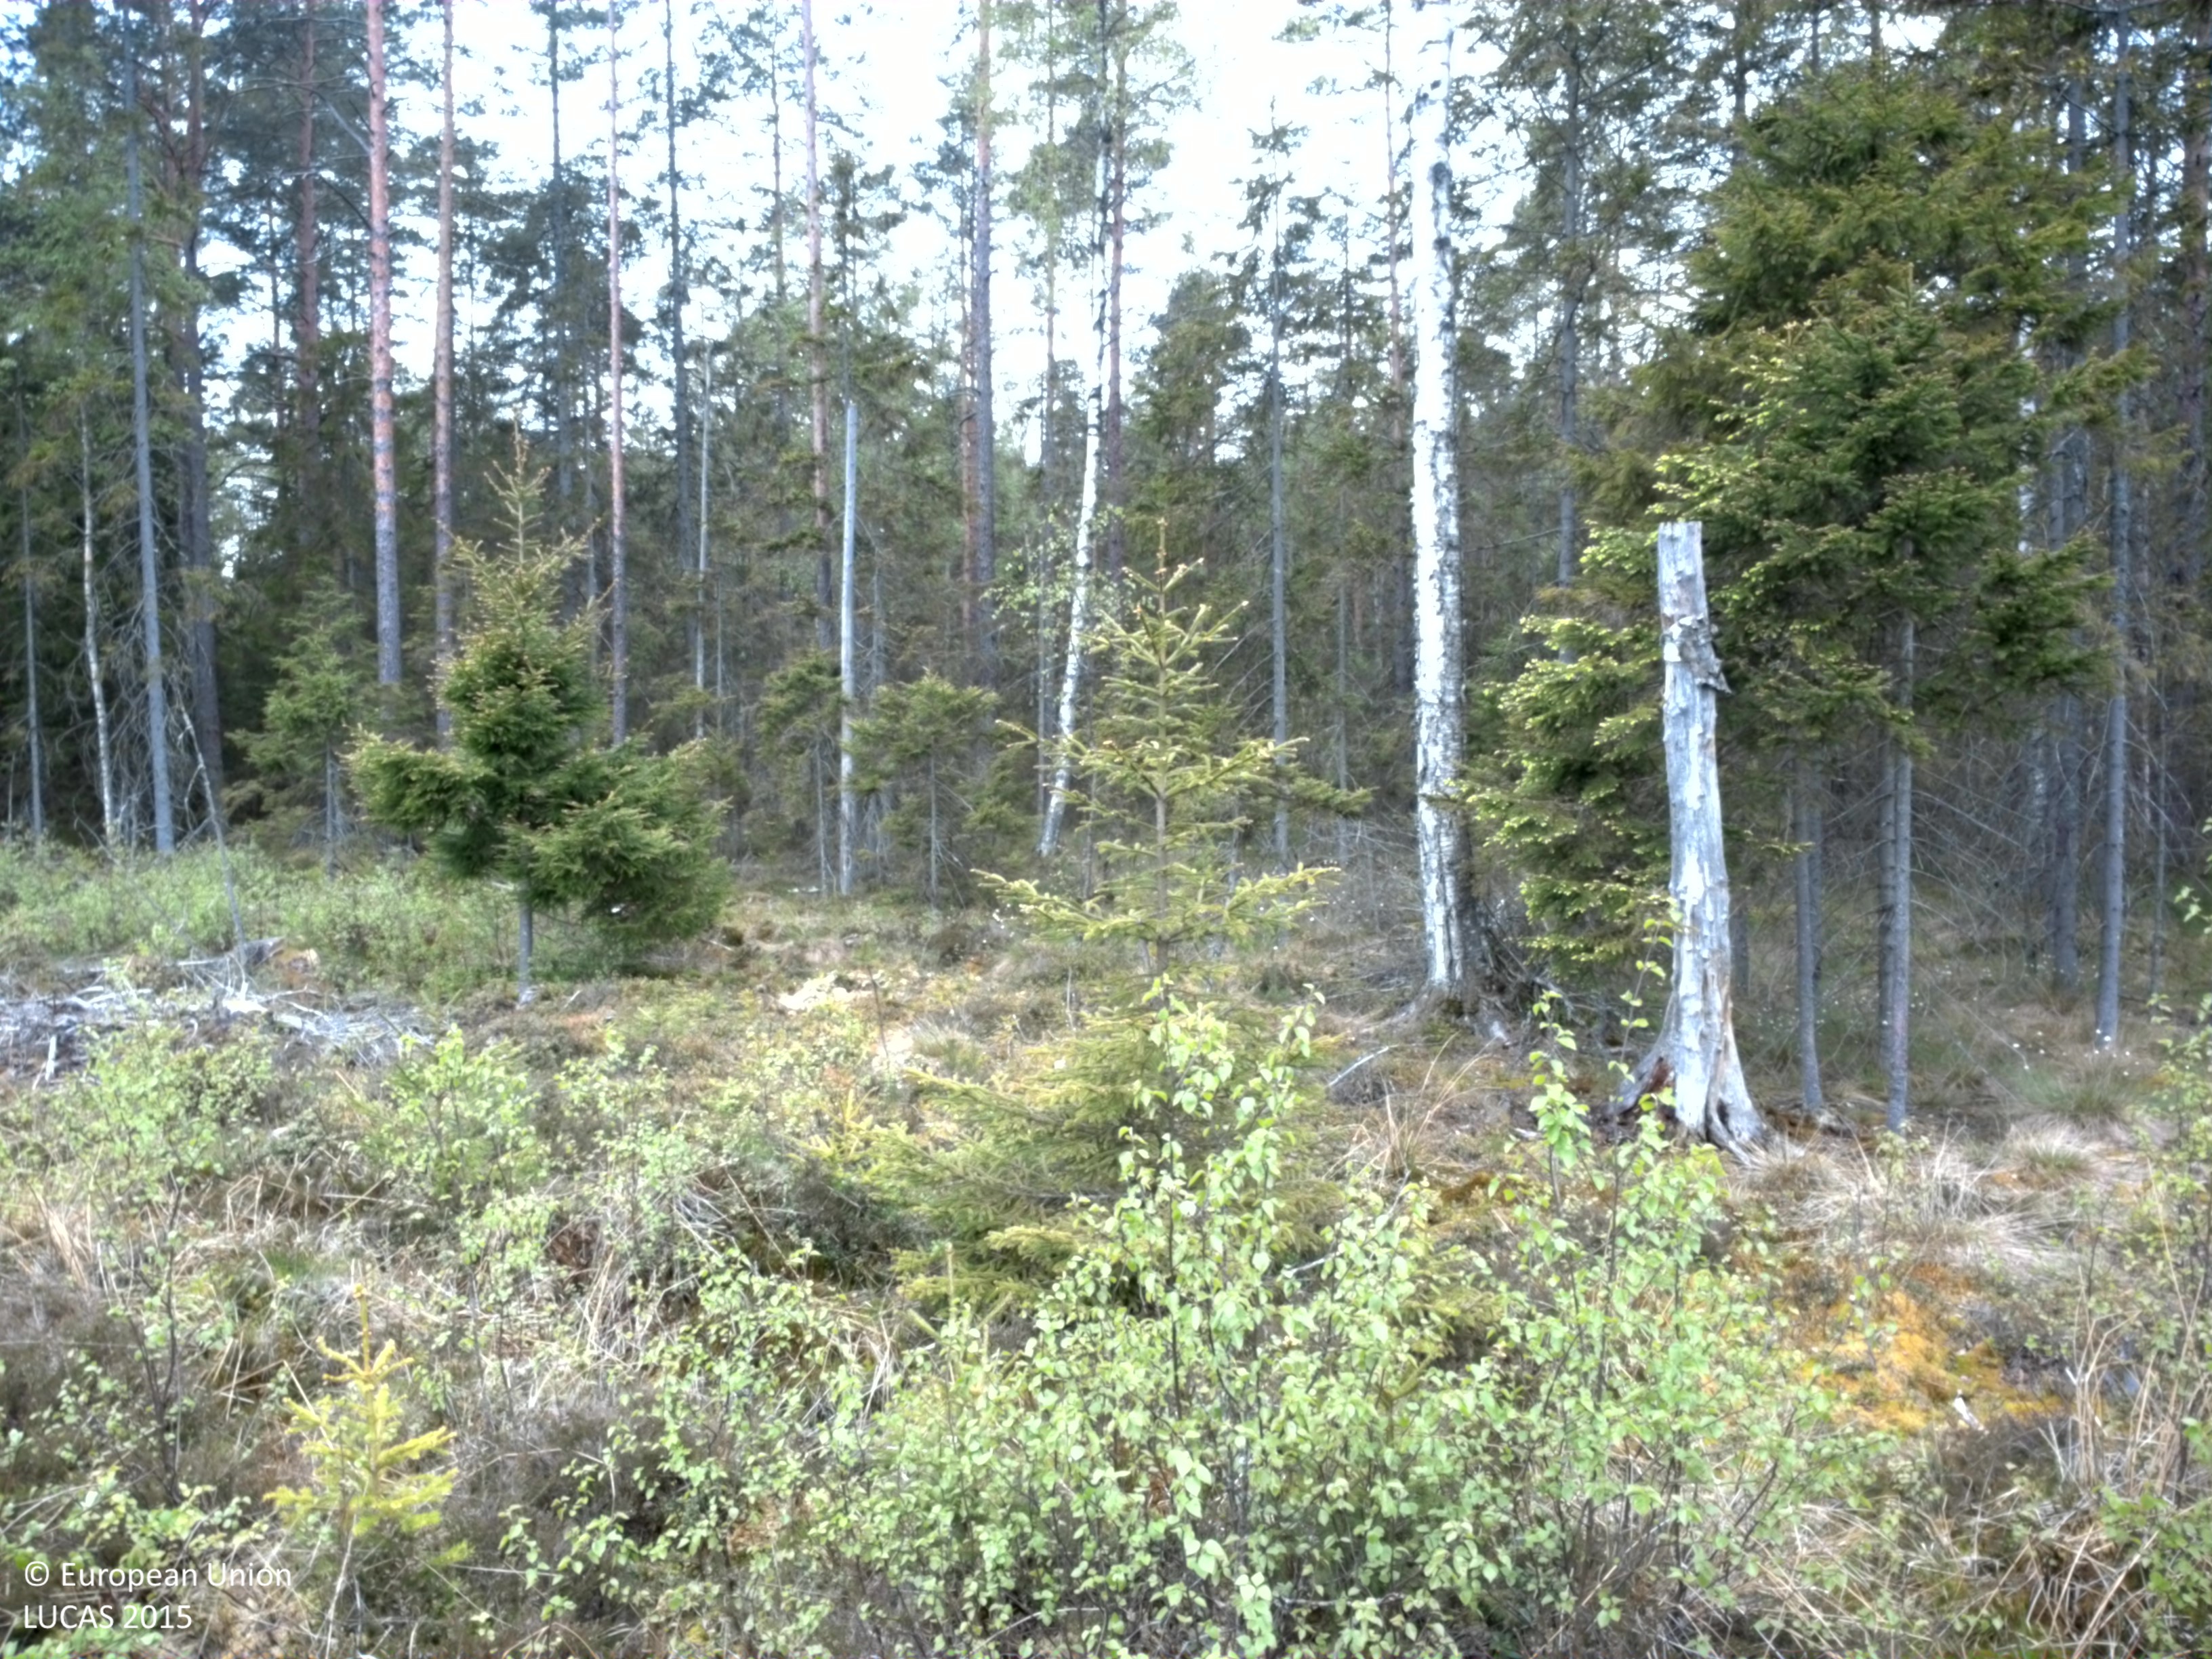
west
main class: Woodland
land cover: Spruce dominated mixed woodland
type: boreal forest
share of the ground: 50 - 75 %
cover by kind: broadleaved forest trees 40 %, coniferous forest trees 35 %, shrubs 10 %, herbaceous plants 10 %, lichens and mosses 5 %
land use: Forestry
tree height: < 5 m
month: May
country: SE
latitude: 56.9099
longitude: 15.2366
